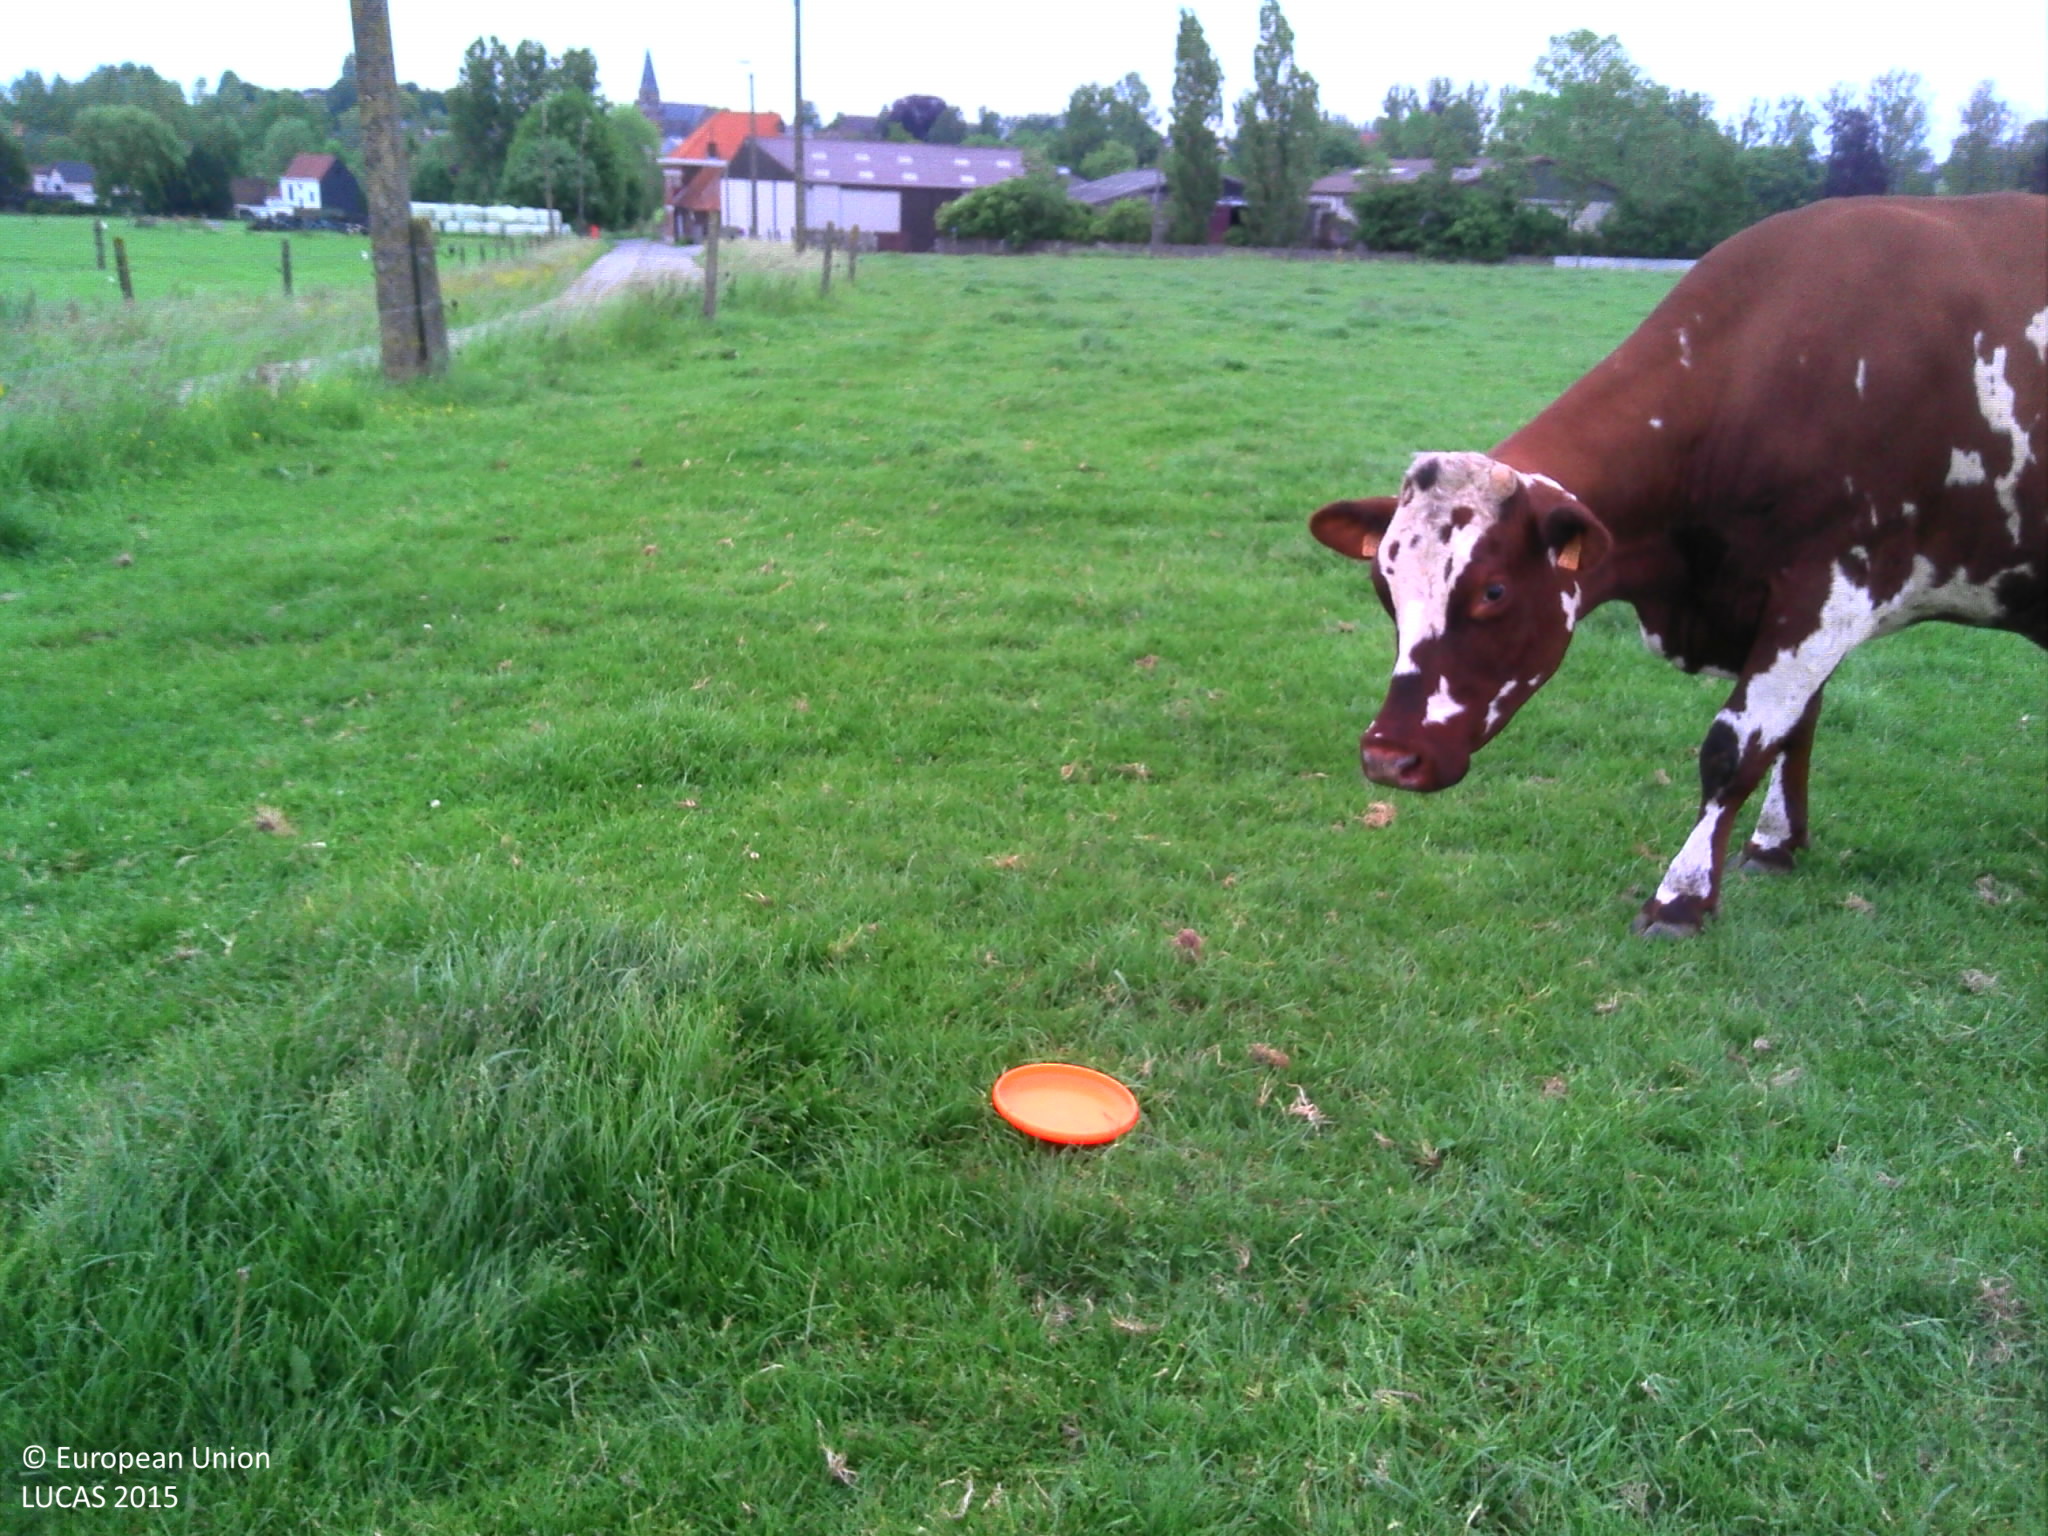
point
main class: Grassland
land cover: Grassland without tree/shrub cover
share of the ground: > 75 %
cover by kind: herbaceous plants 100 %
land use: Agriculture (excluding fallow land and kitchen gardens)
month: June
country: BE
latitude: 50.8623
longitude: 3.7846
